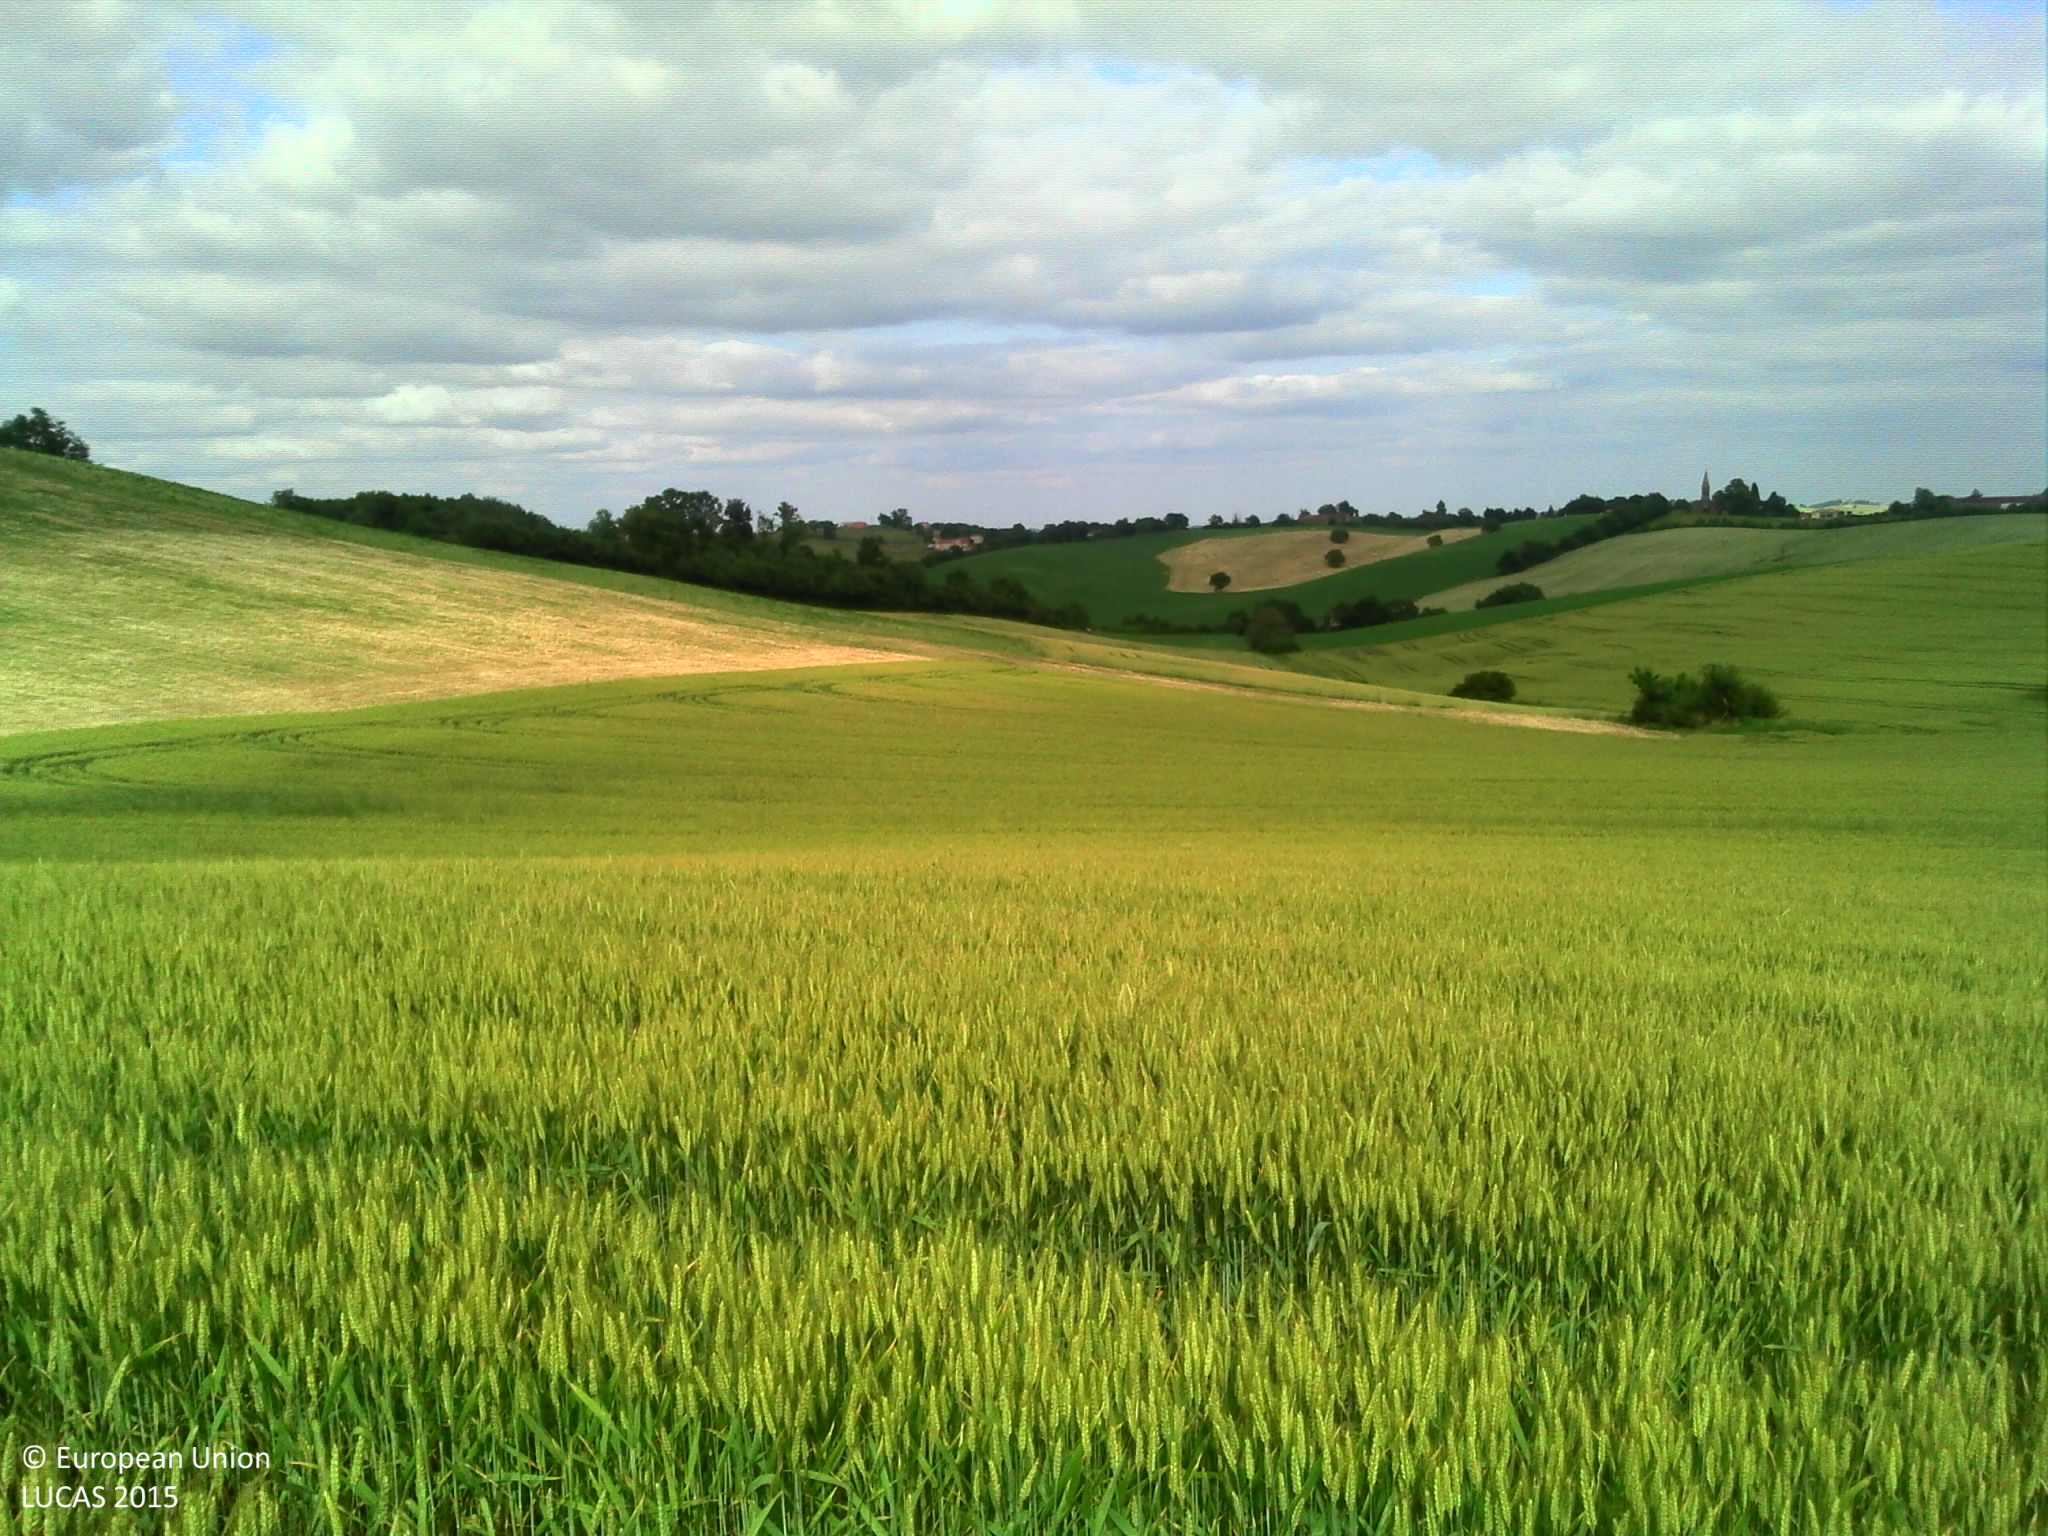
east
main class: Cropland
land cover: Durum wheat
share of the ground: > 75 %
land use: Agriculture (excluding fallow land and kitchen gardens)
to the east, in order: Durum wheat; Temporary grasslands; Grass margins; Temporary grasslands; Durum wheat
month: June
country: FR
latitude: 43.5334
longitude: 0.7060
